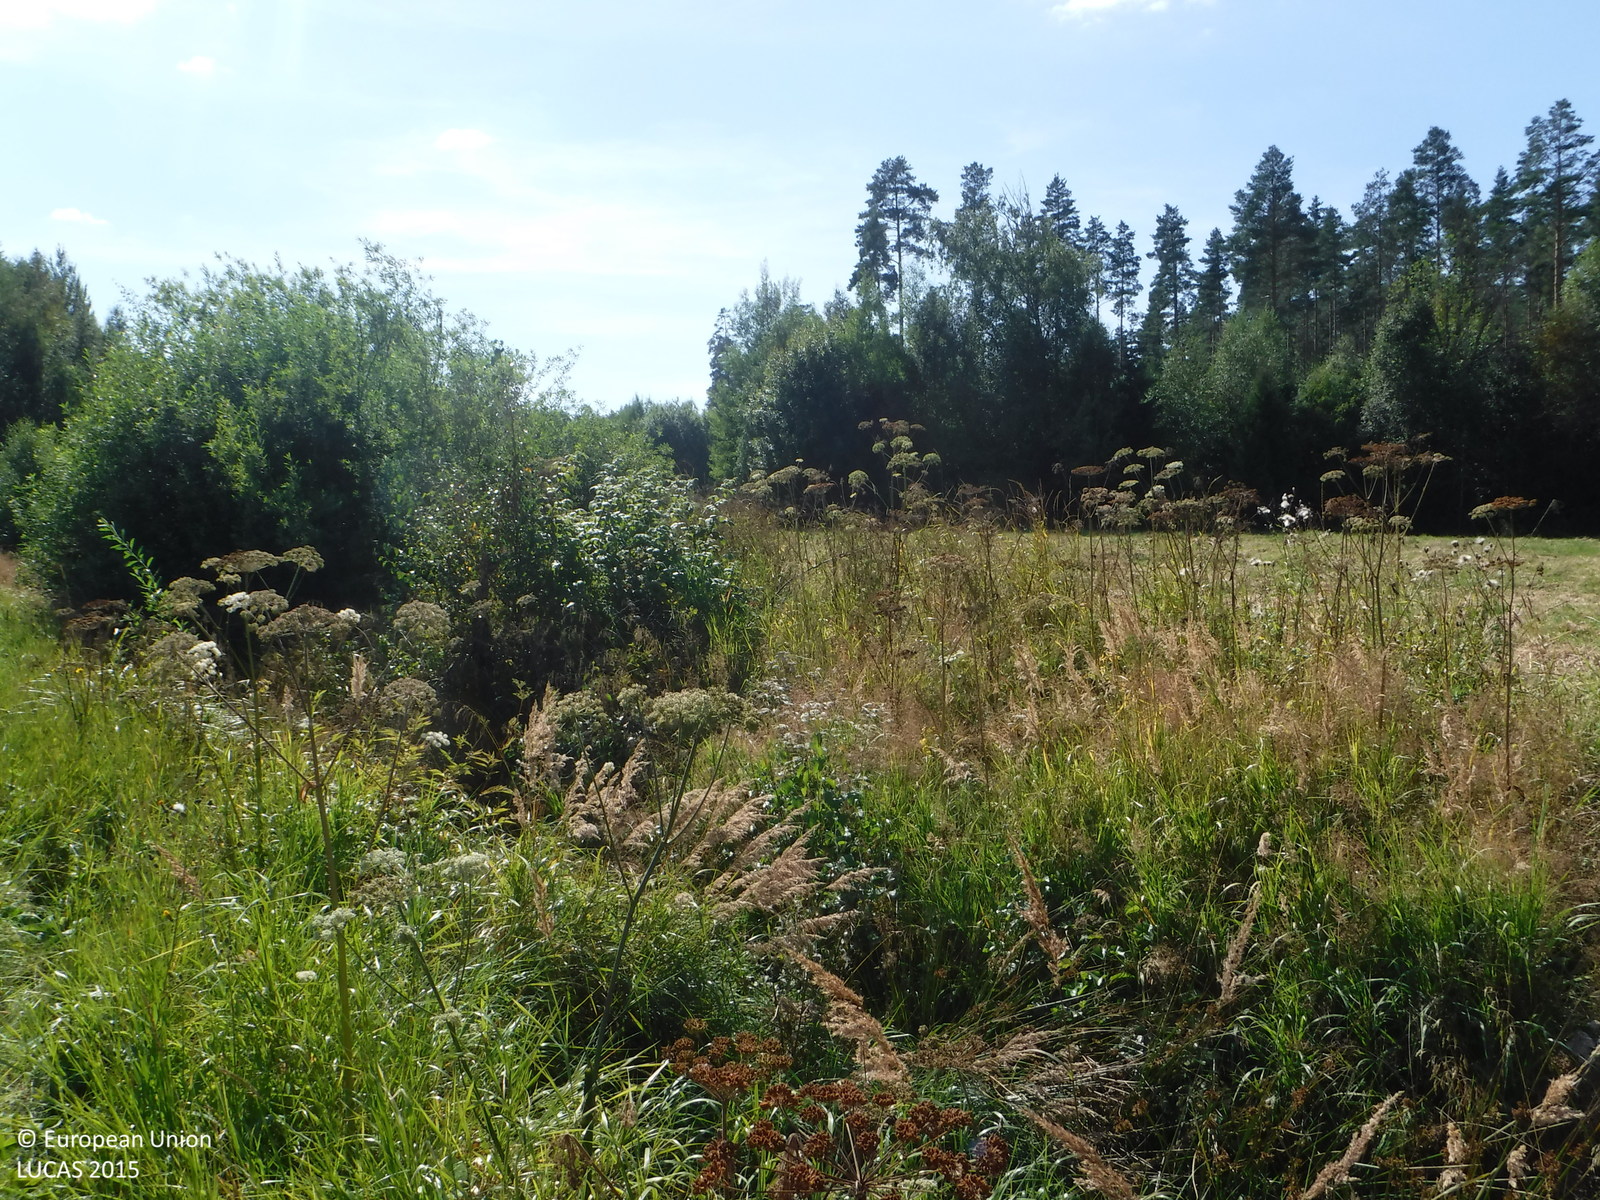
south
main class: Cropland
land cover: Common wheat
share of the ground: > 75 %
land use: Agriculture (excluding fallow land and kitchen gardens)
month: August
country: FI
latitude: 61.1171
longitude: 22.1055
